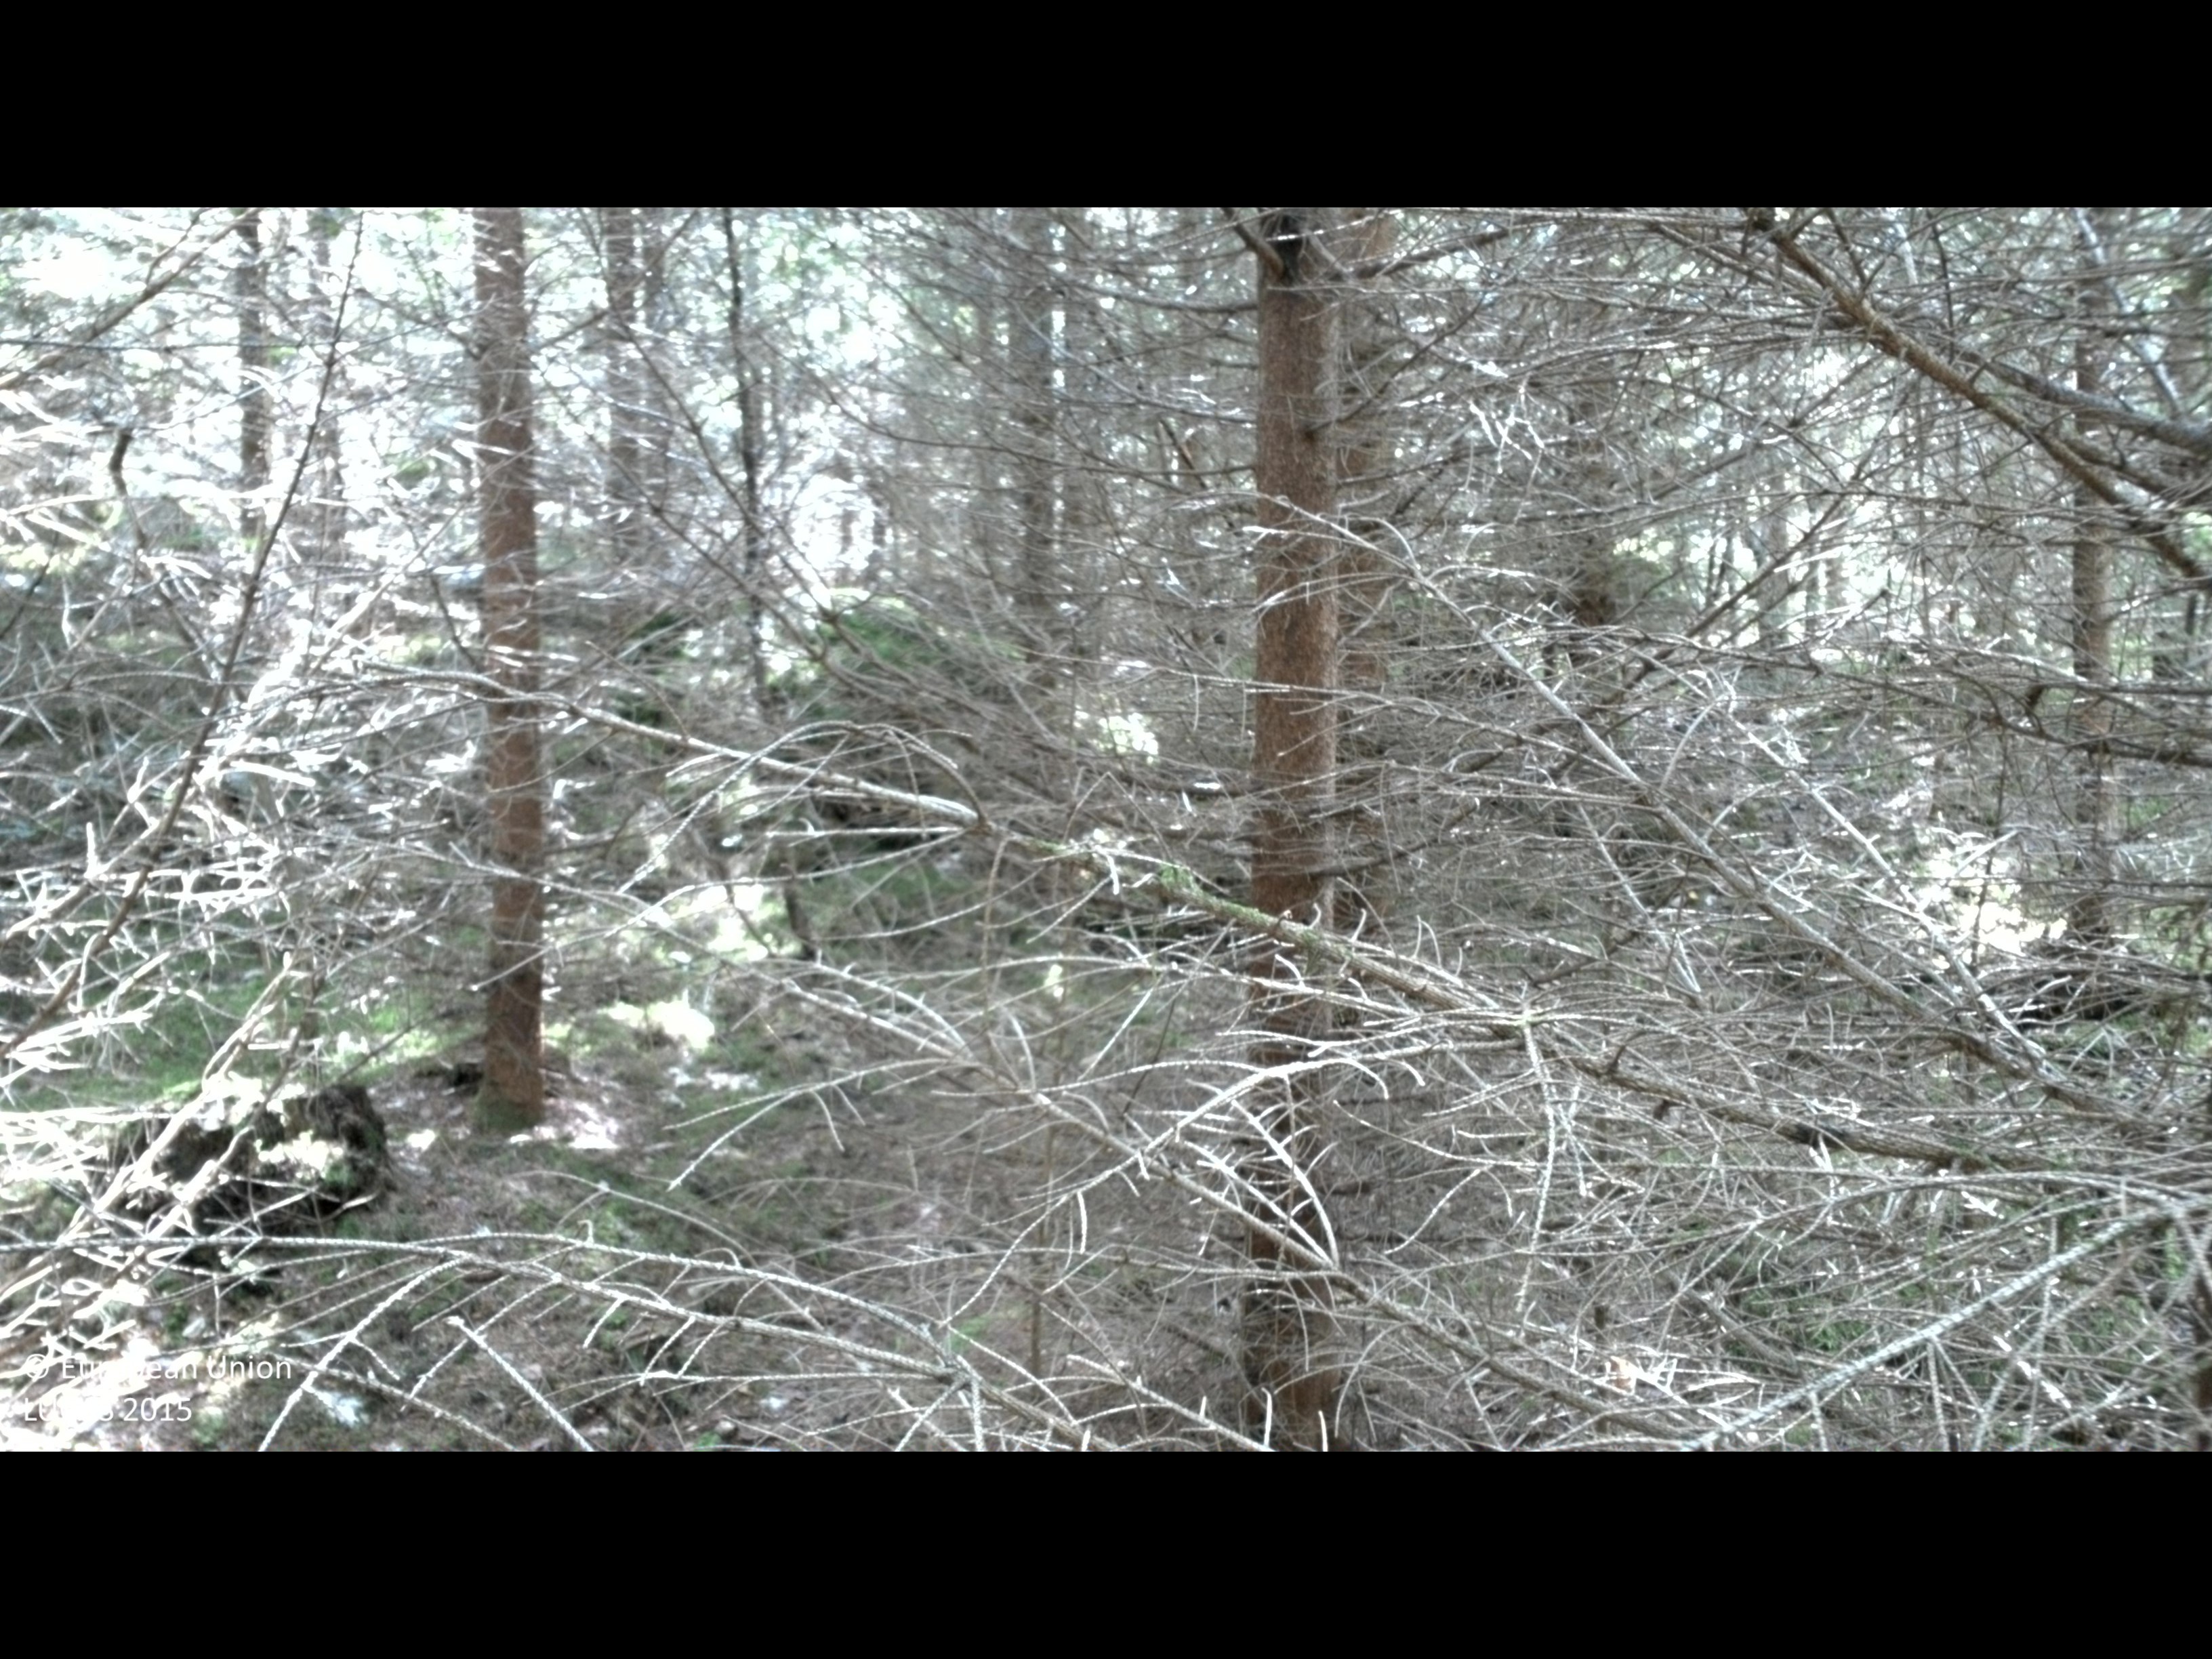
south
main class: Woodland
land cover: Spruce dominated coniferous woodland
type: boreal forest
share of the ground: > 75 %
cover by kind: coniferous forest trees 90 %, lichens and mosses 10 %
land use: Forestry
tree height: < 5 m
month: August
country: SE
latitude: 56.3953
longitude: 14.5501
